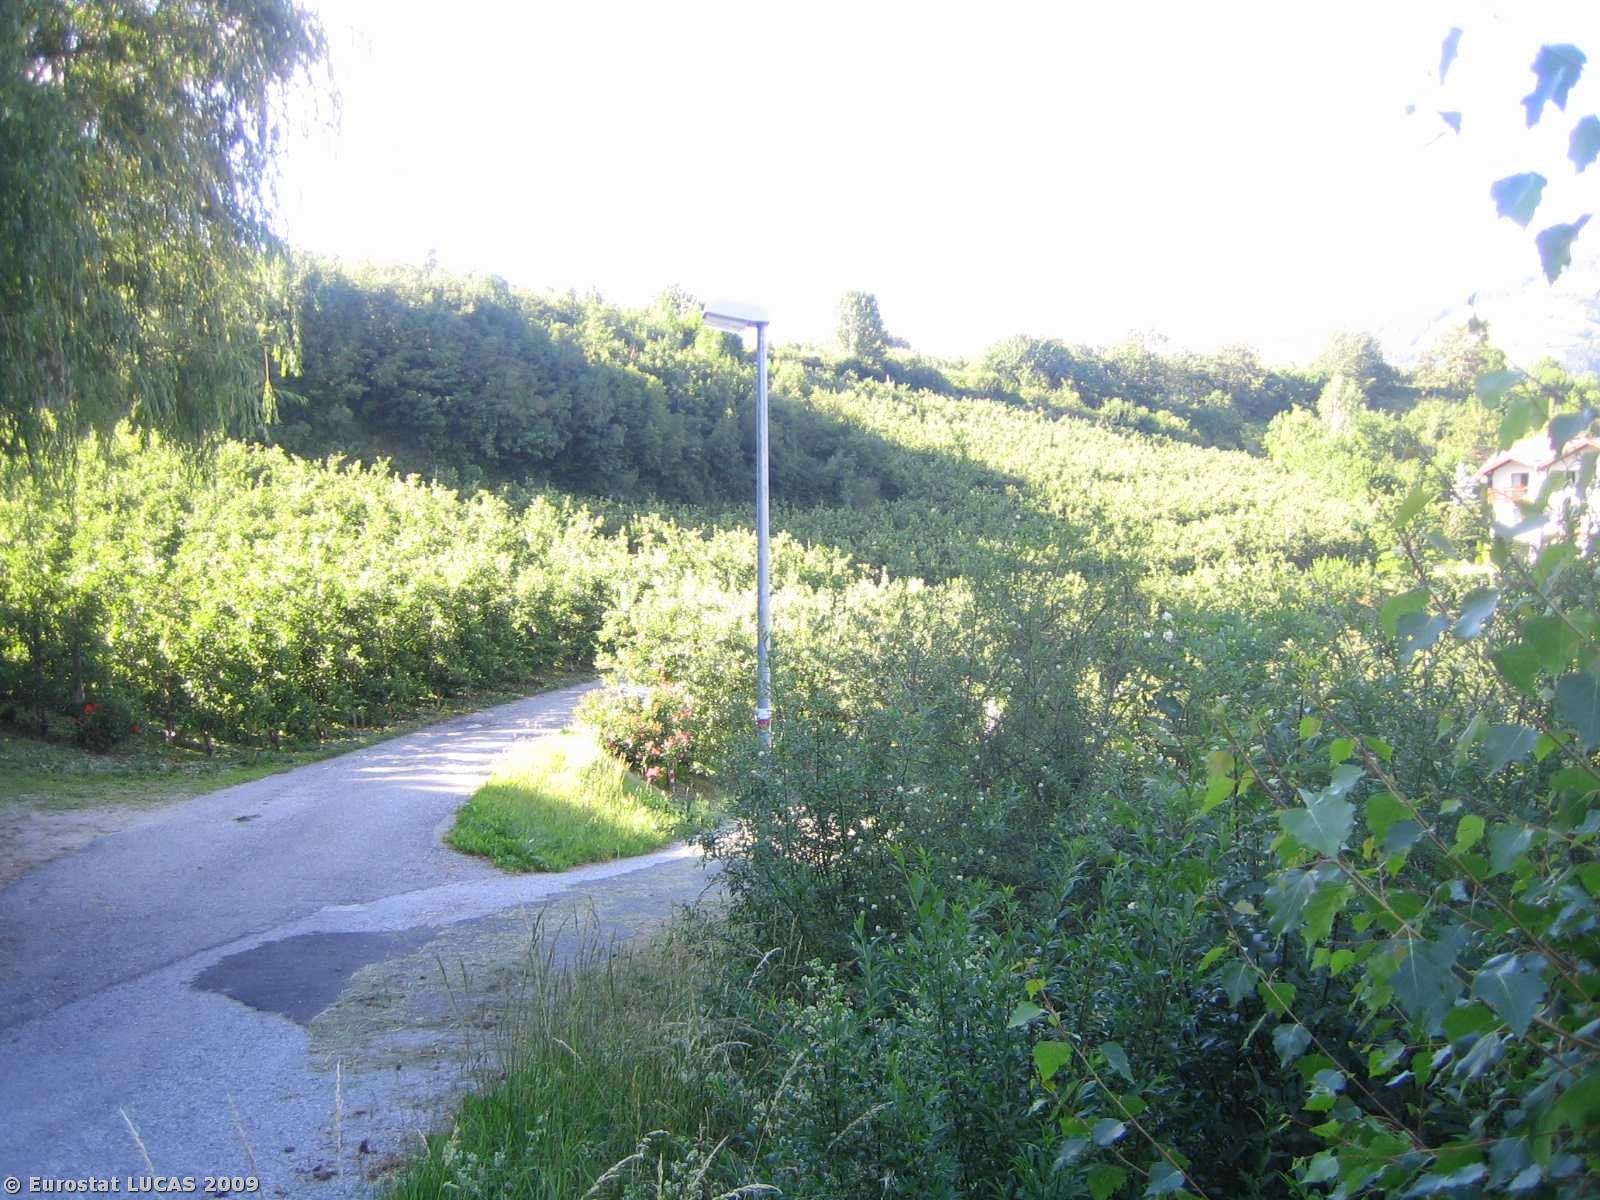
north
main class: Cropland
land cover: Apple fruit
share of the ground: 50 - 75 %
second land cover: Grassland with sparse tree/shrub cover
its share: > 75 %
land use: Agriculture (excluding fallow land and kitchen gardens)
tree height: < 5 m
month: June
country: IT
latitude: 46.7522
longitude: 11.6869
